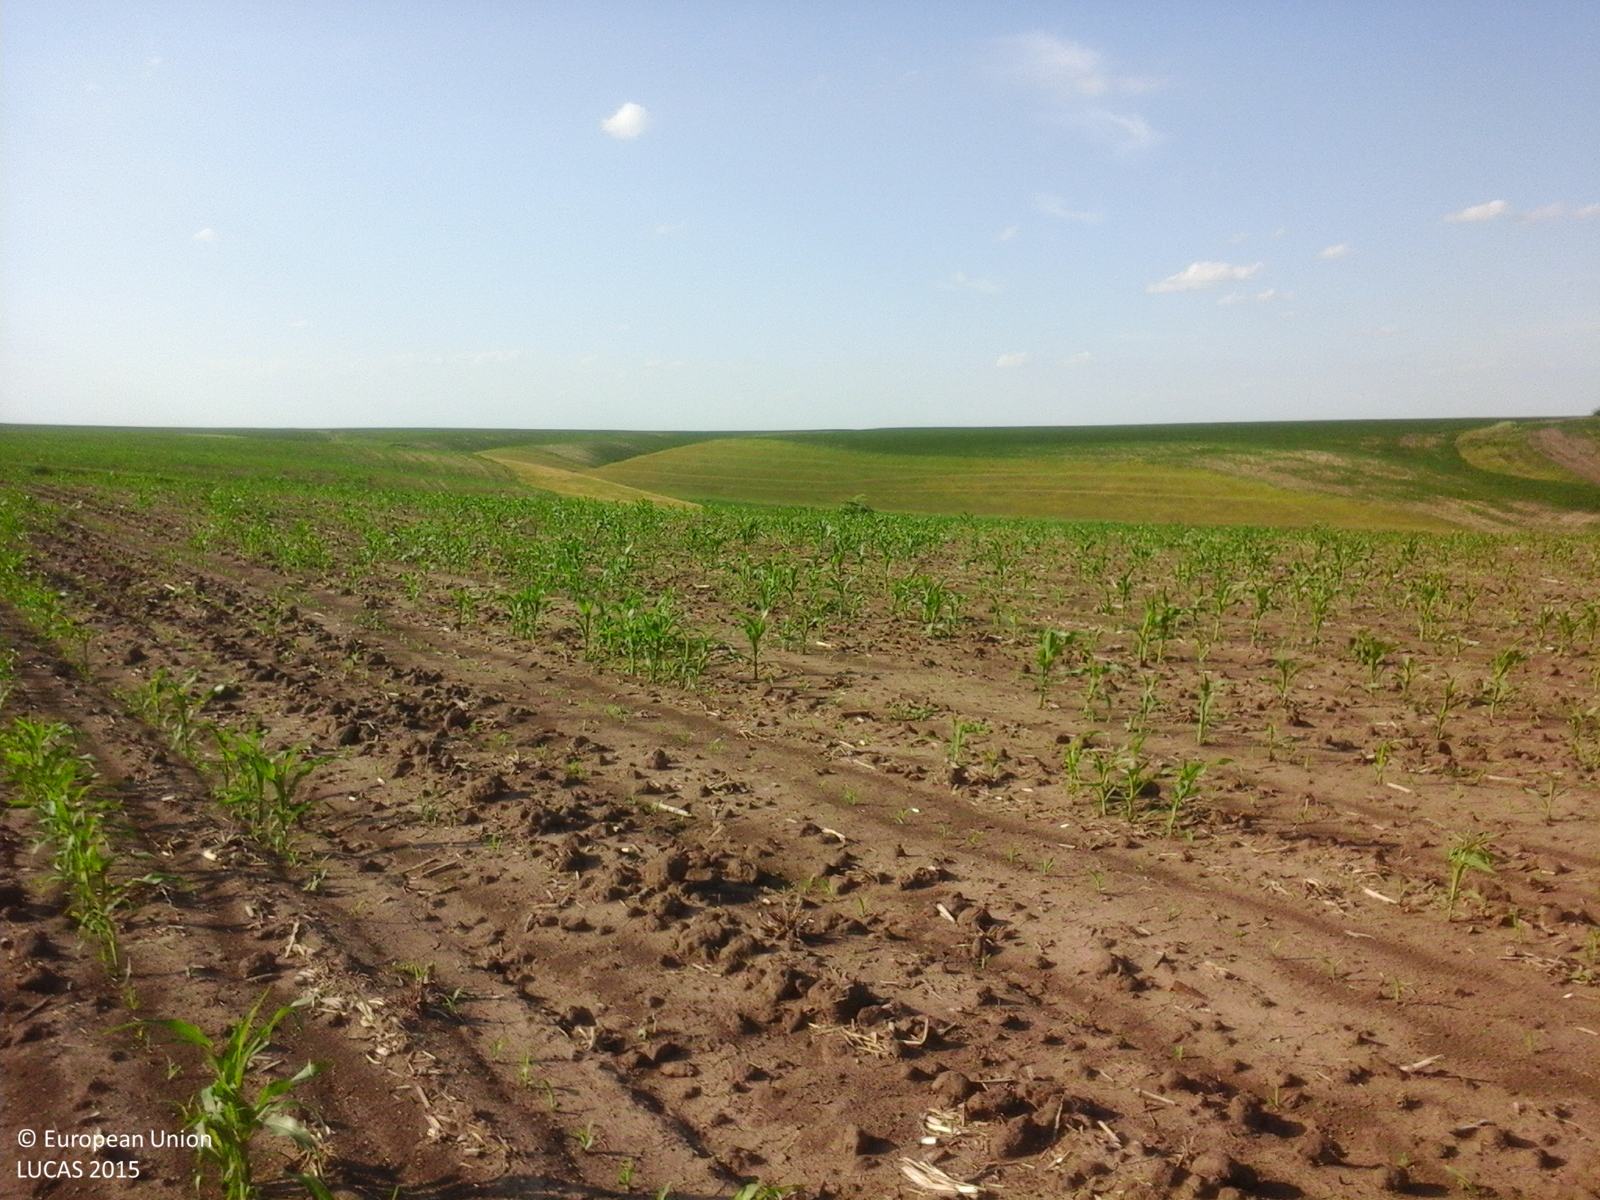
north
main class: Cropland
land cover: Maize
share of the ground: 10 - 25 %
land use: Agriculture (excluding fallow land and kitchen gardens)
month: June
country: RO
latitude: 47.8654
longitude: 26.5210
